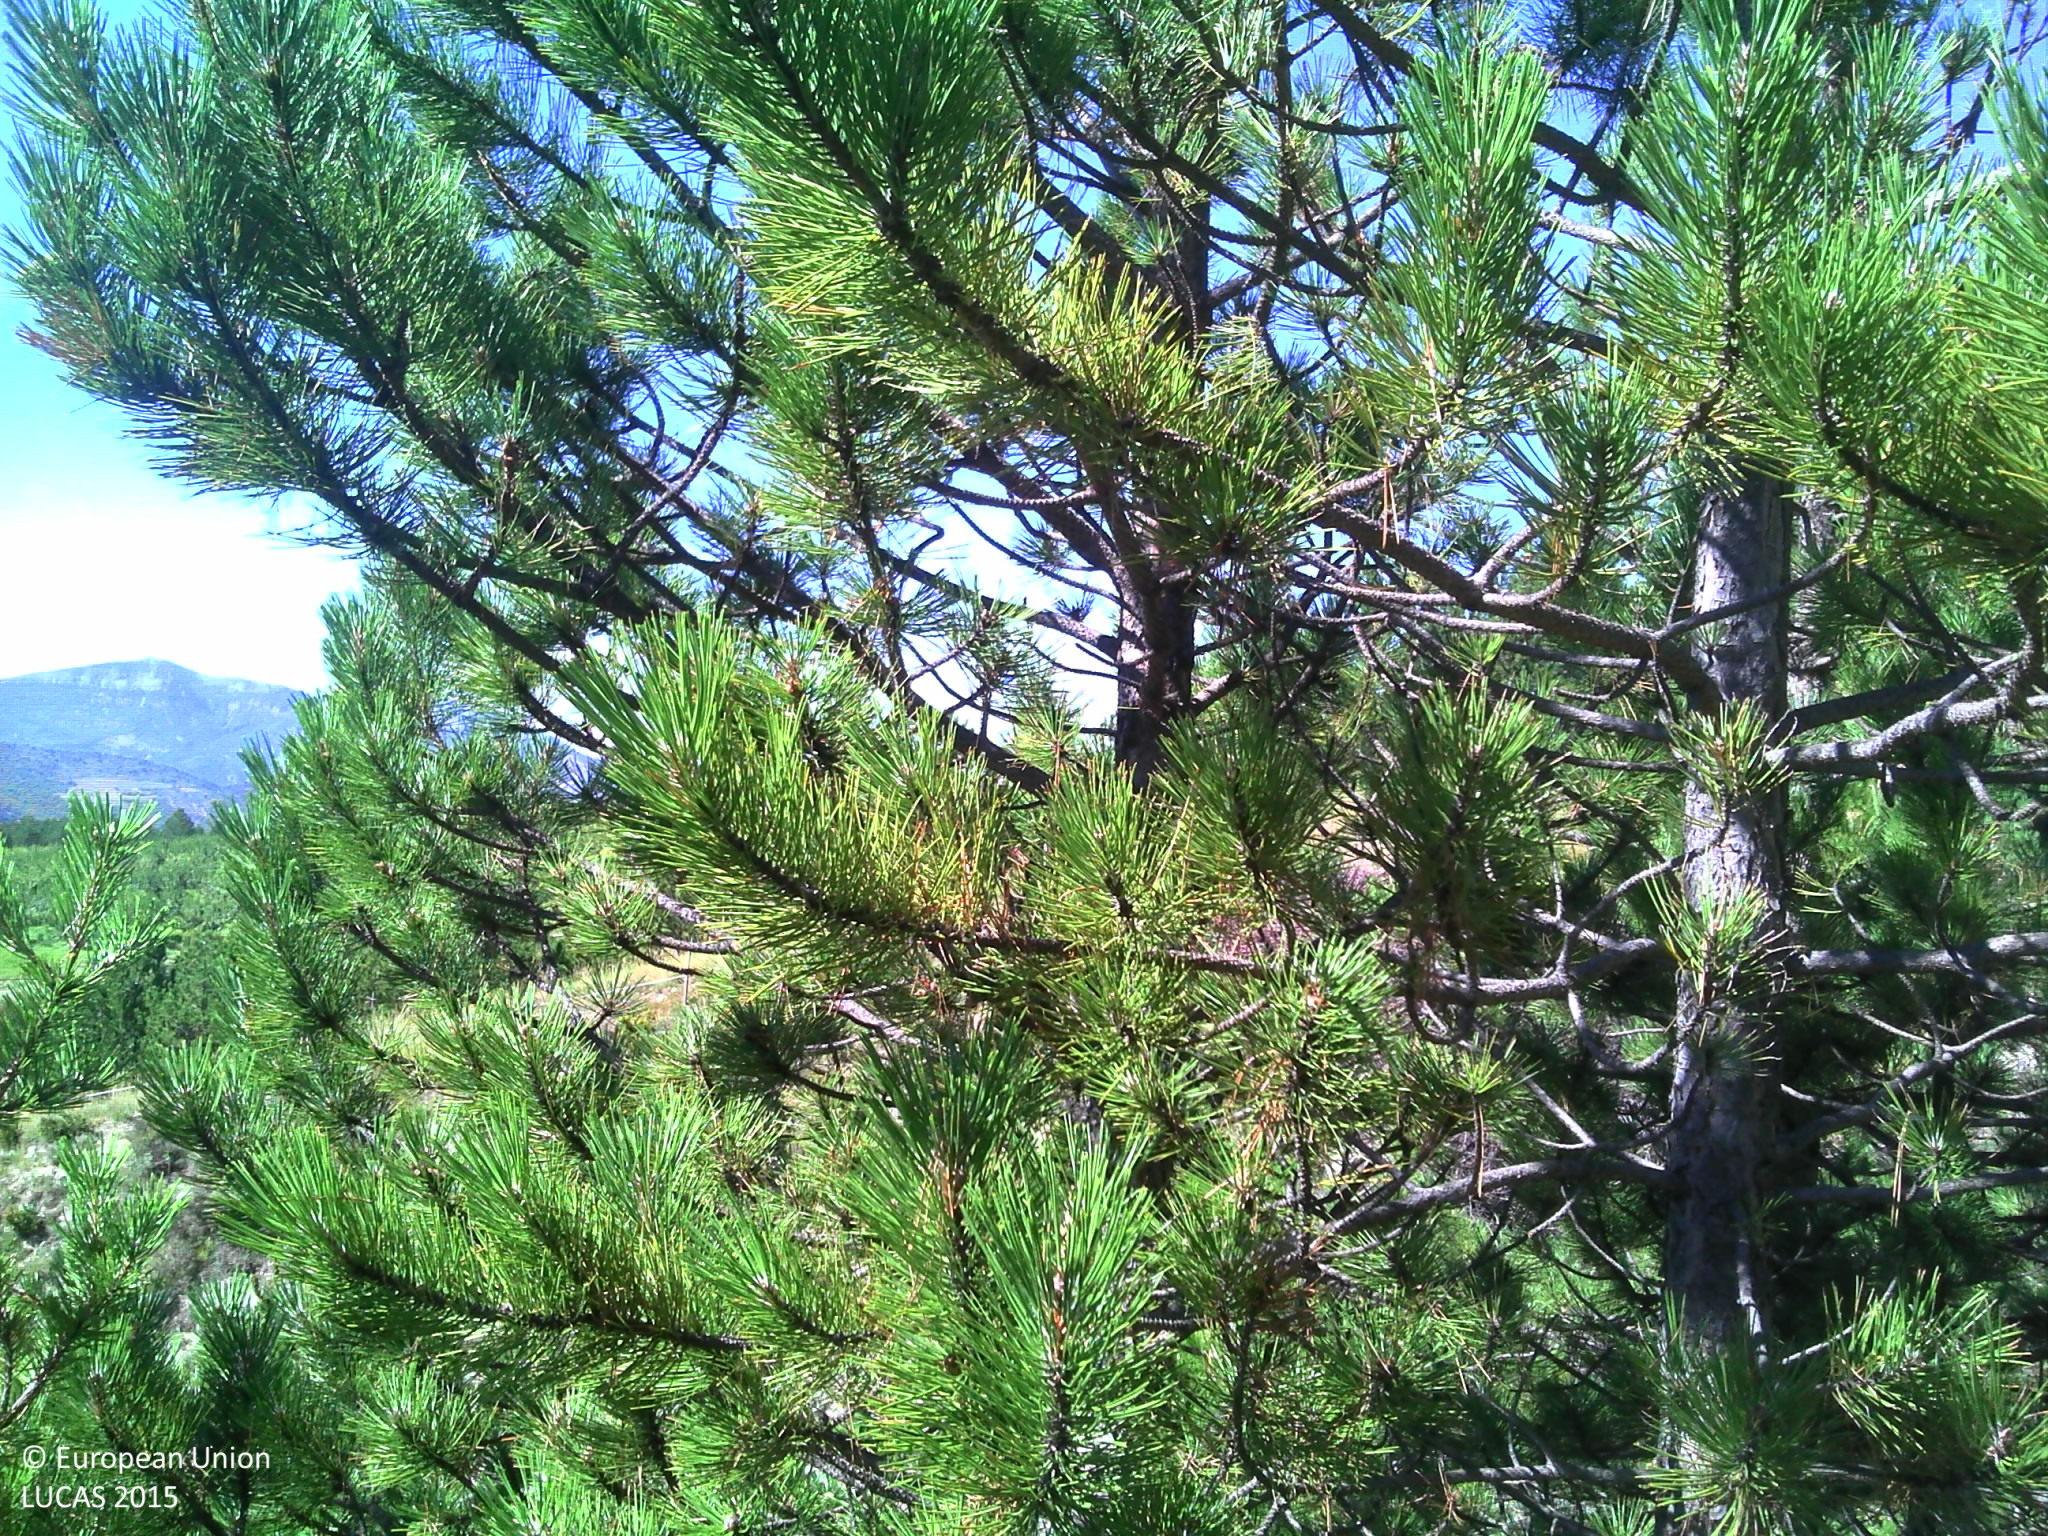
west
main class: Woodland
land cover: Pine dominated coniferous woodland
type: coniferous forest of the mediterranean region
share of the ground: > 75 %
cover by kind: coniferous forest trees 95 %, broadleaved forest trees 5 %
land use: Forestry
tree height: > 5 m
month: September
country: FR
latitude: 44.3875
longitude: 5.2749
